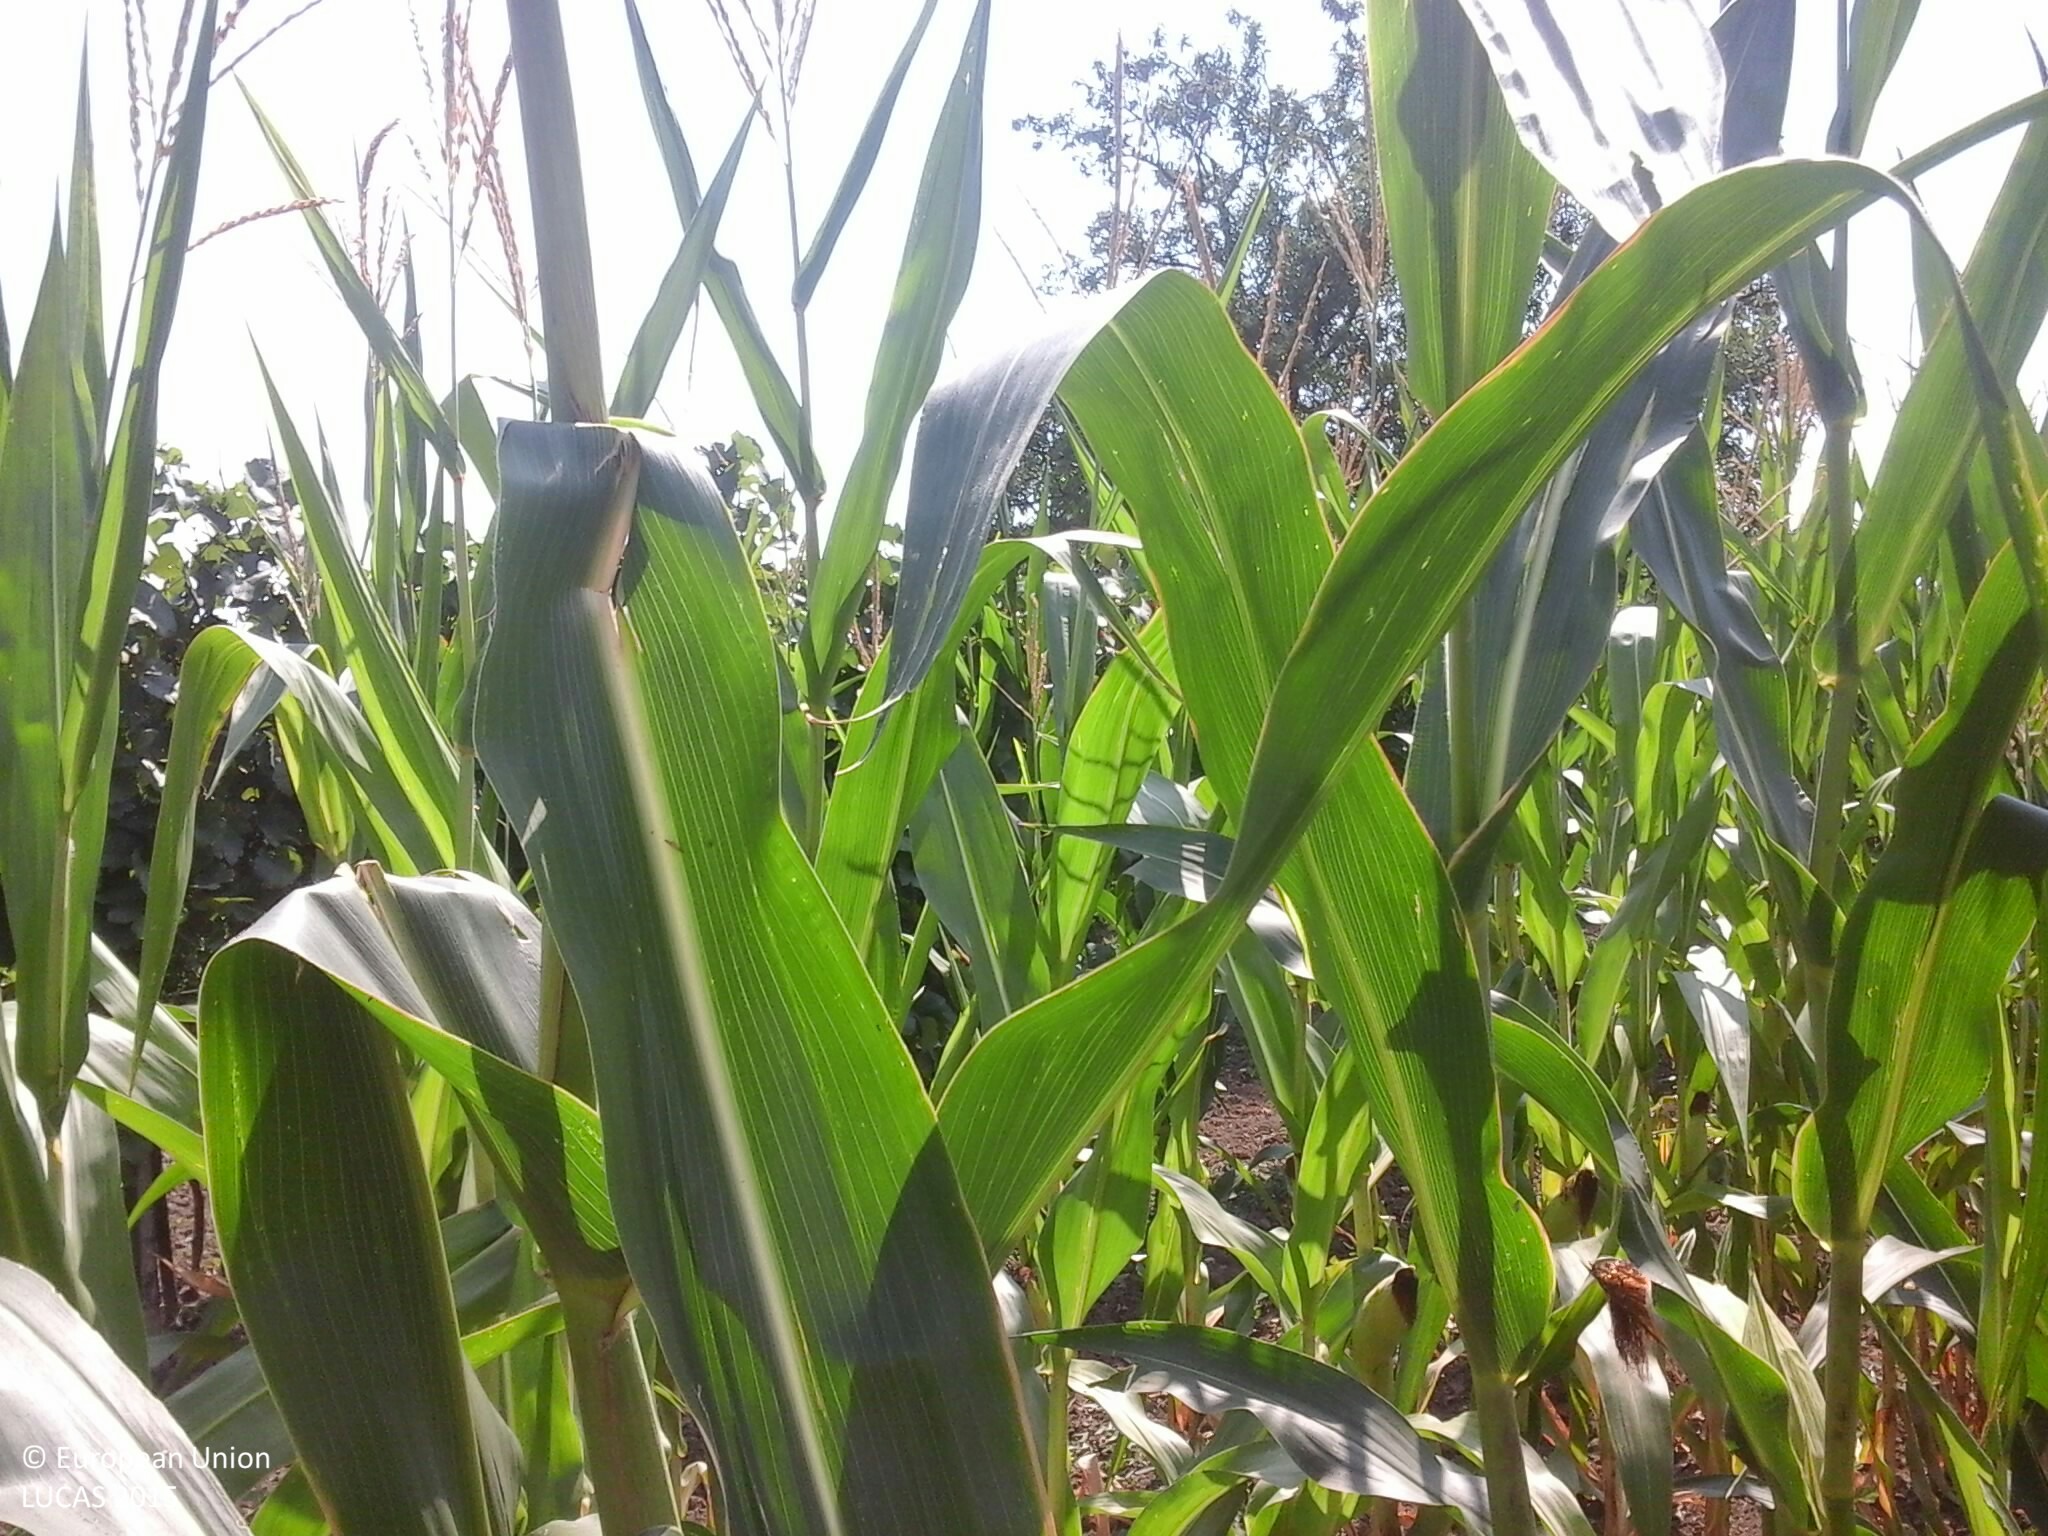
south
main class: Cropland
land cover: Maize
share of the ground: > 75 %
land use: Agriculture (excluding fallow land and kitchen gardens)
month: August
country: HU
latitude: 47.0088
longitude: 18.2578
